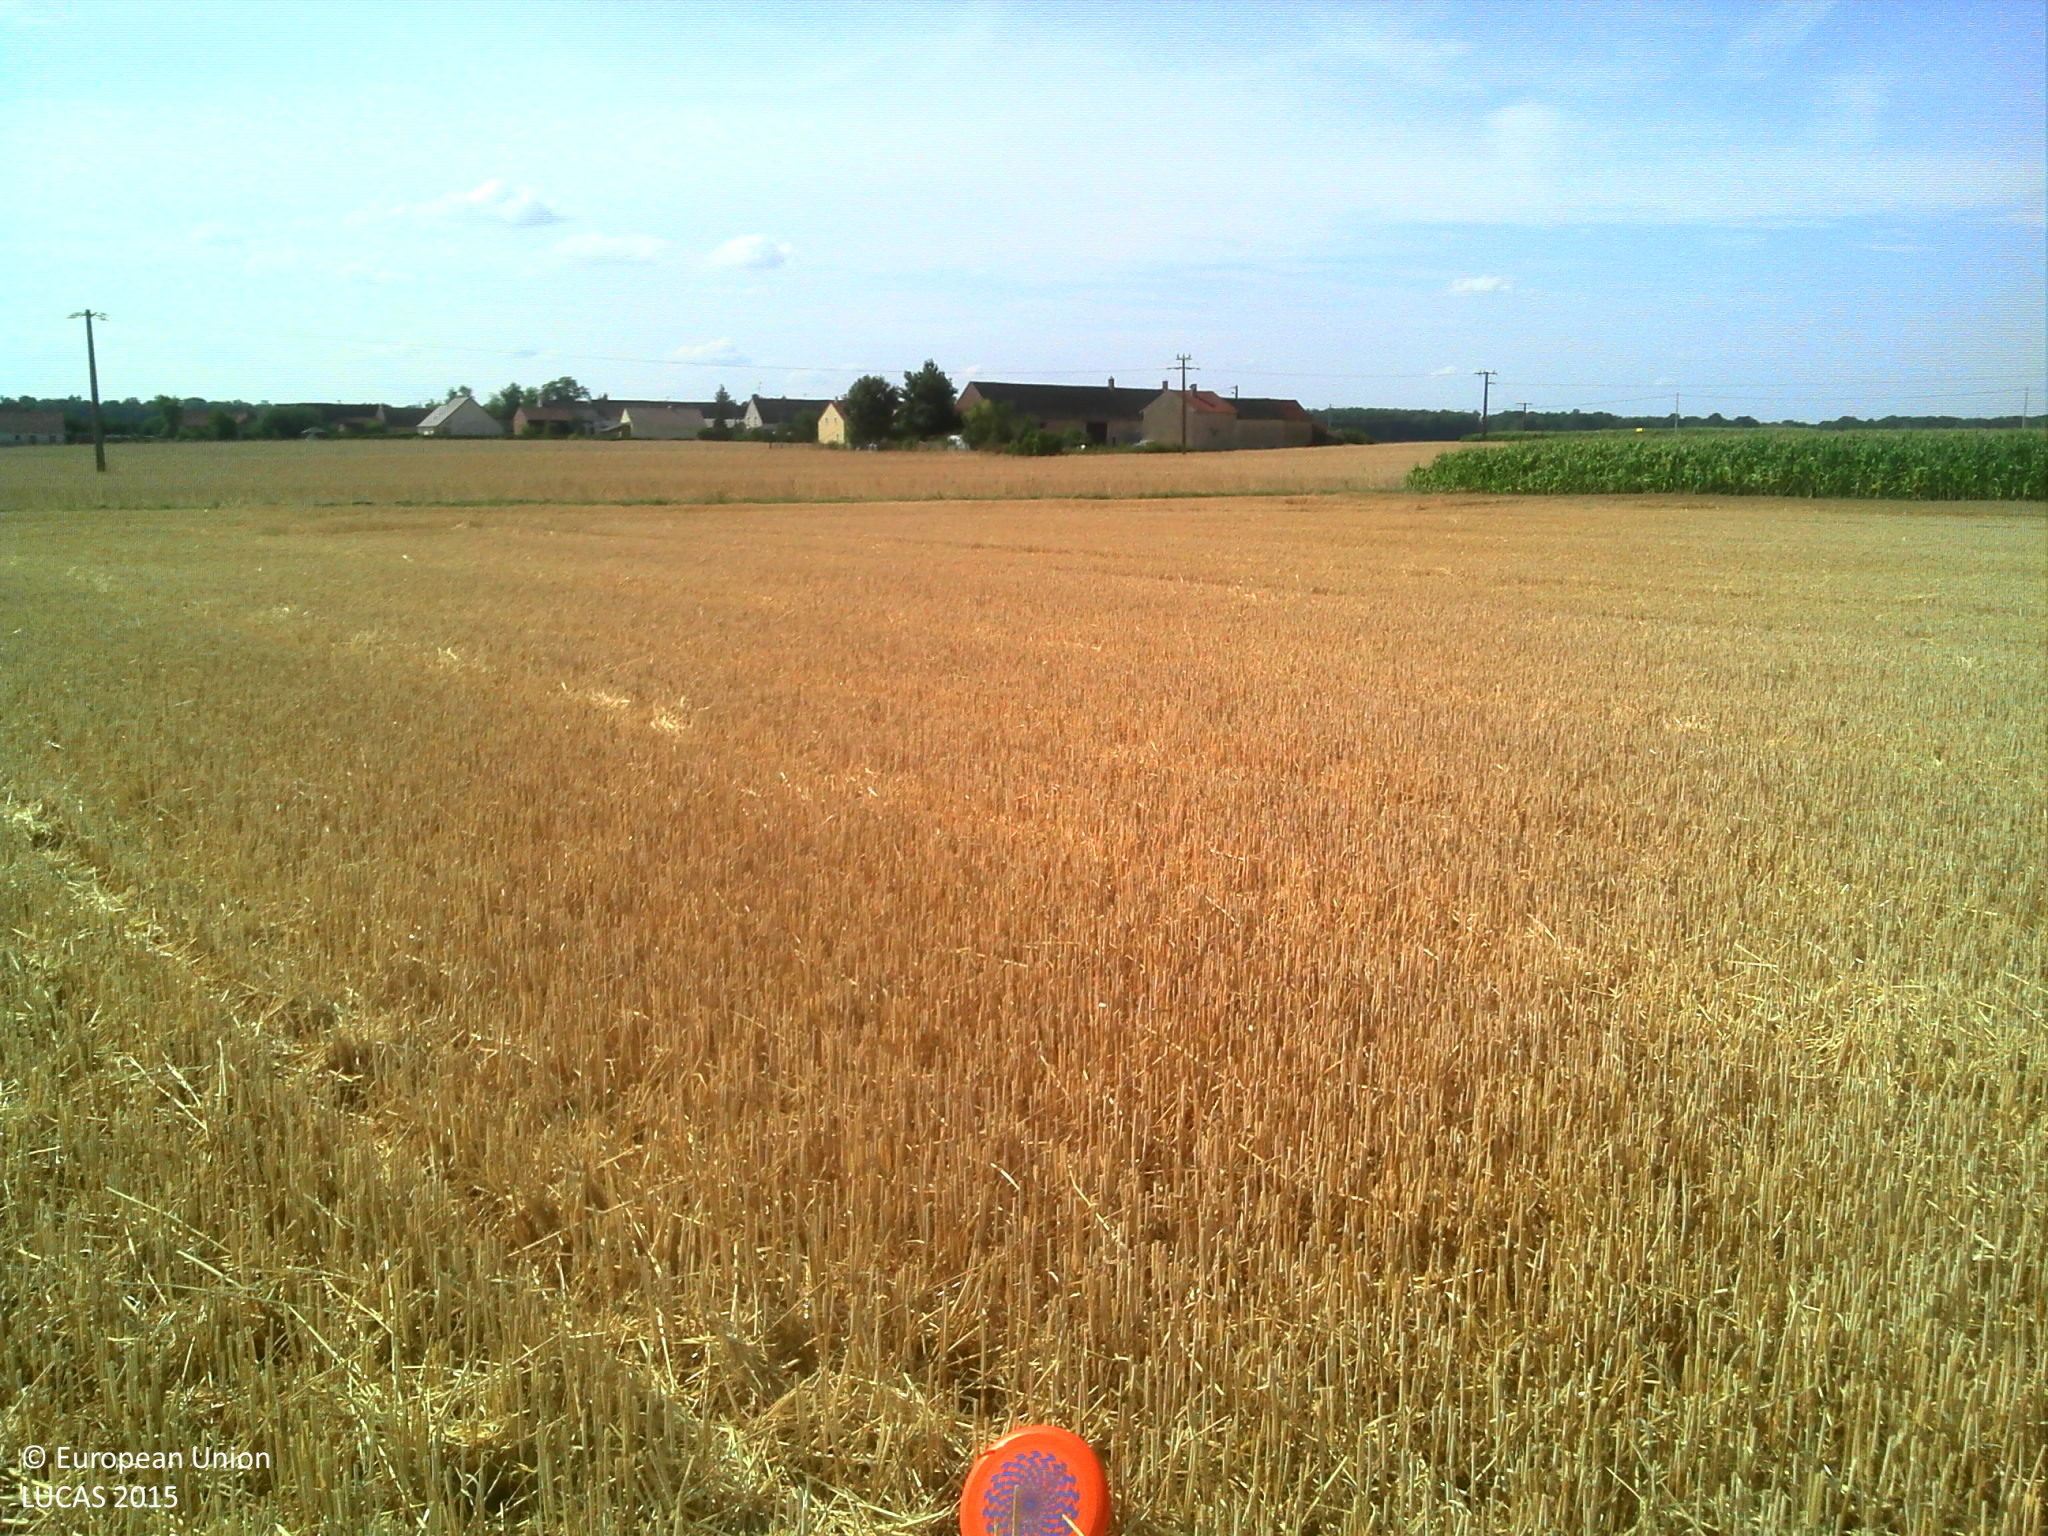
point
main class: Cropland
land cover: Common wheat
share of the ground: > 75 %
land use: Agriculture (excluding fallow land and kitchen gardens)
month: July
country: FR
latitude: 46.9198
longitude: 4.9981
